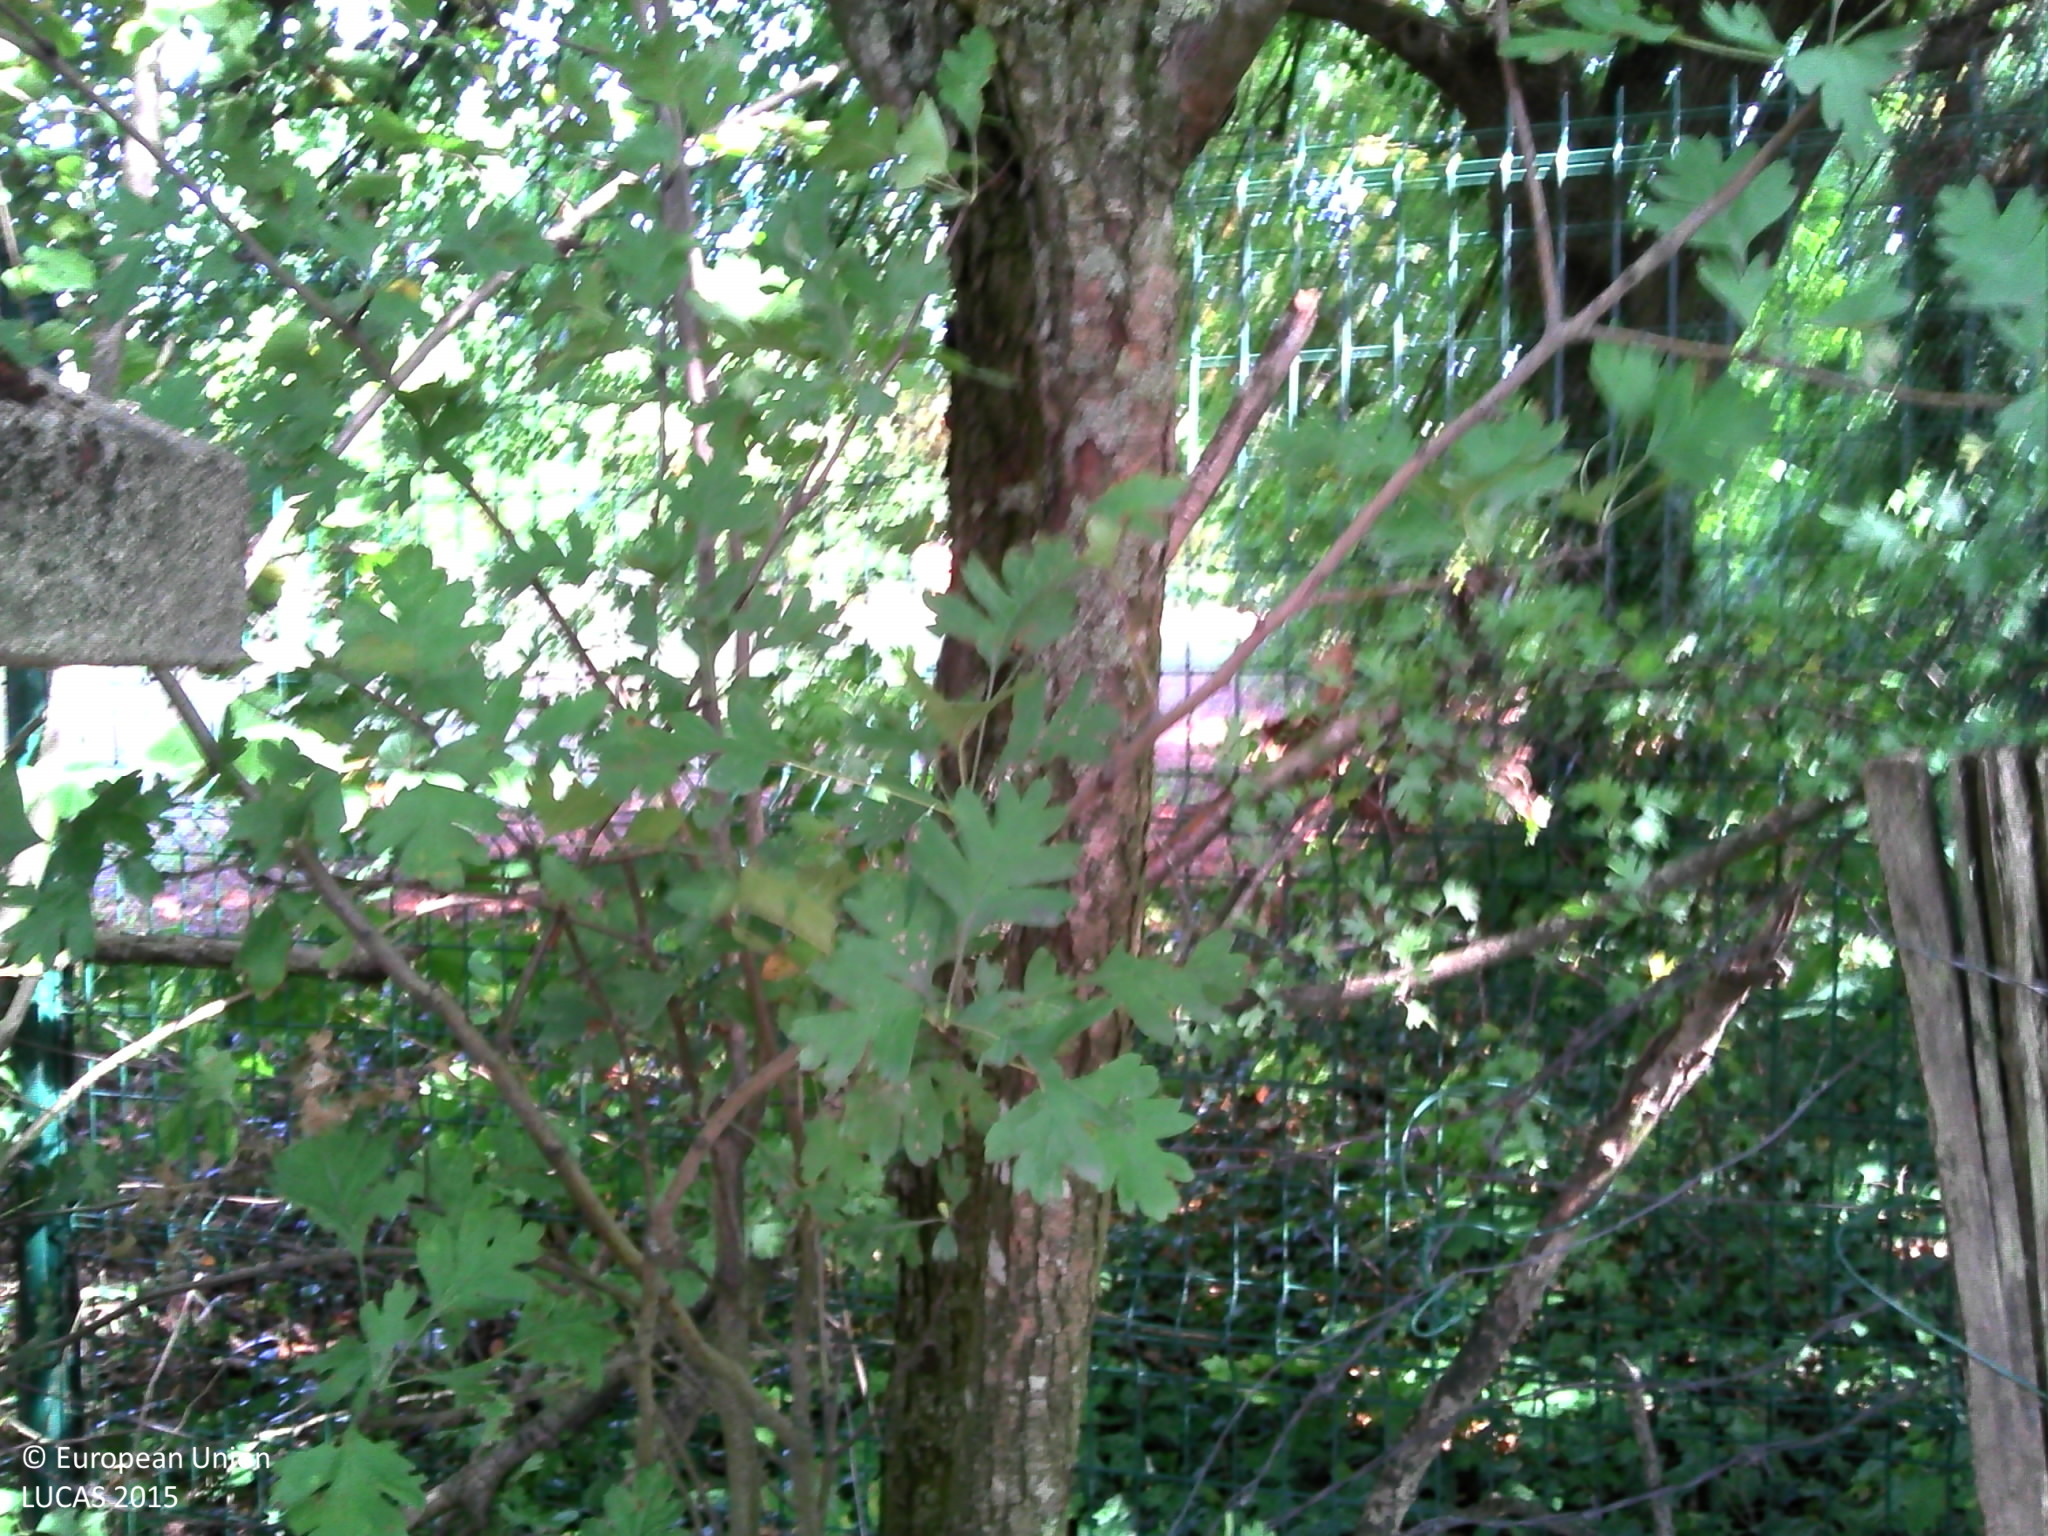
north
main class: Grassland
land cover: Grassland with sparse tree/shrub cover
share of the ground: > 75 %
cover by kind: herbaceous plants 95 %, broadleaved forest trees 5 %
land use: Amenities, museums, leisure
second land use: Residential
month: August
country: FR
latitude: 47.7998
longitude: 3.5470
